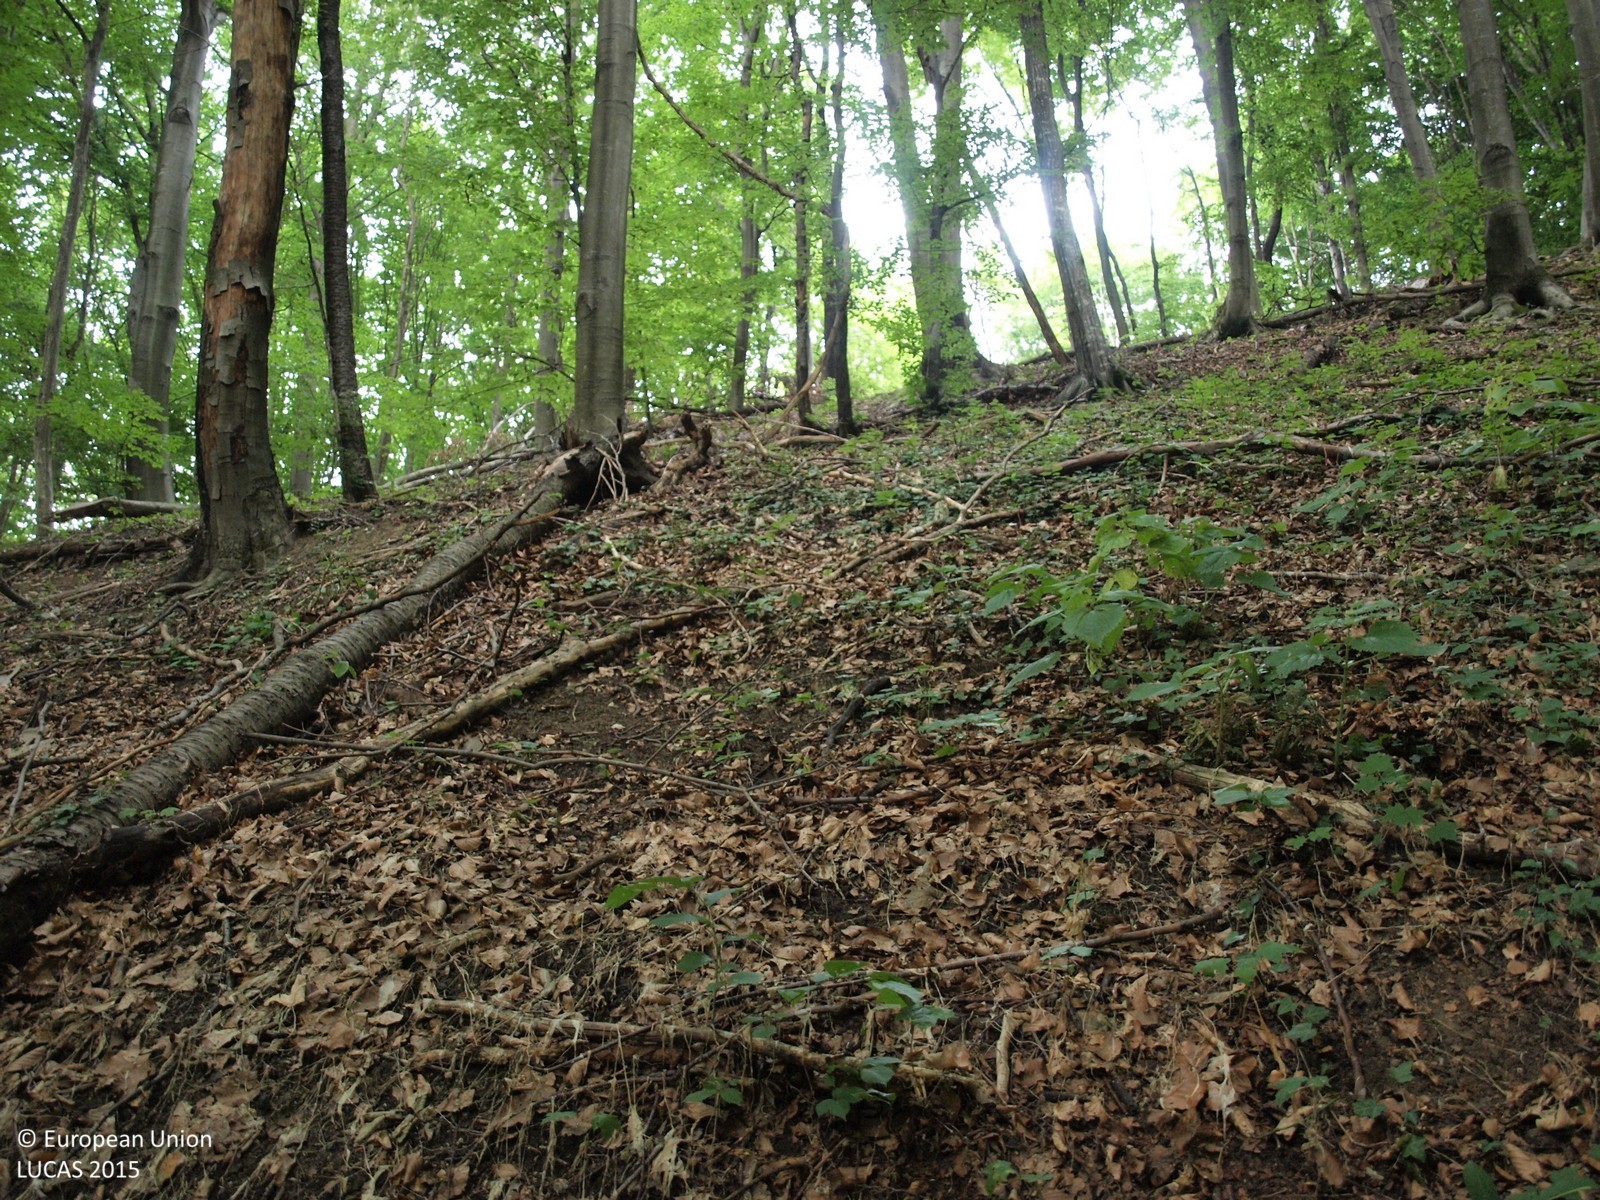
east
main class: Woodland
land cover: Broadleaved woodland
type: beech forest
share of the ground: > 75 %
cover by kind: broadleaved forest trees 90 %, shrubs 5 %, herbaceous plants 5 %
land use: Forestry
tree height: > 5 m
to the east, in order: Broadleaved woodland; Tracks; Broadleaved woodland
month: July
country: HR
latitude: 46.2033
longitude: 16.5712
